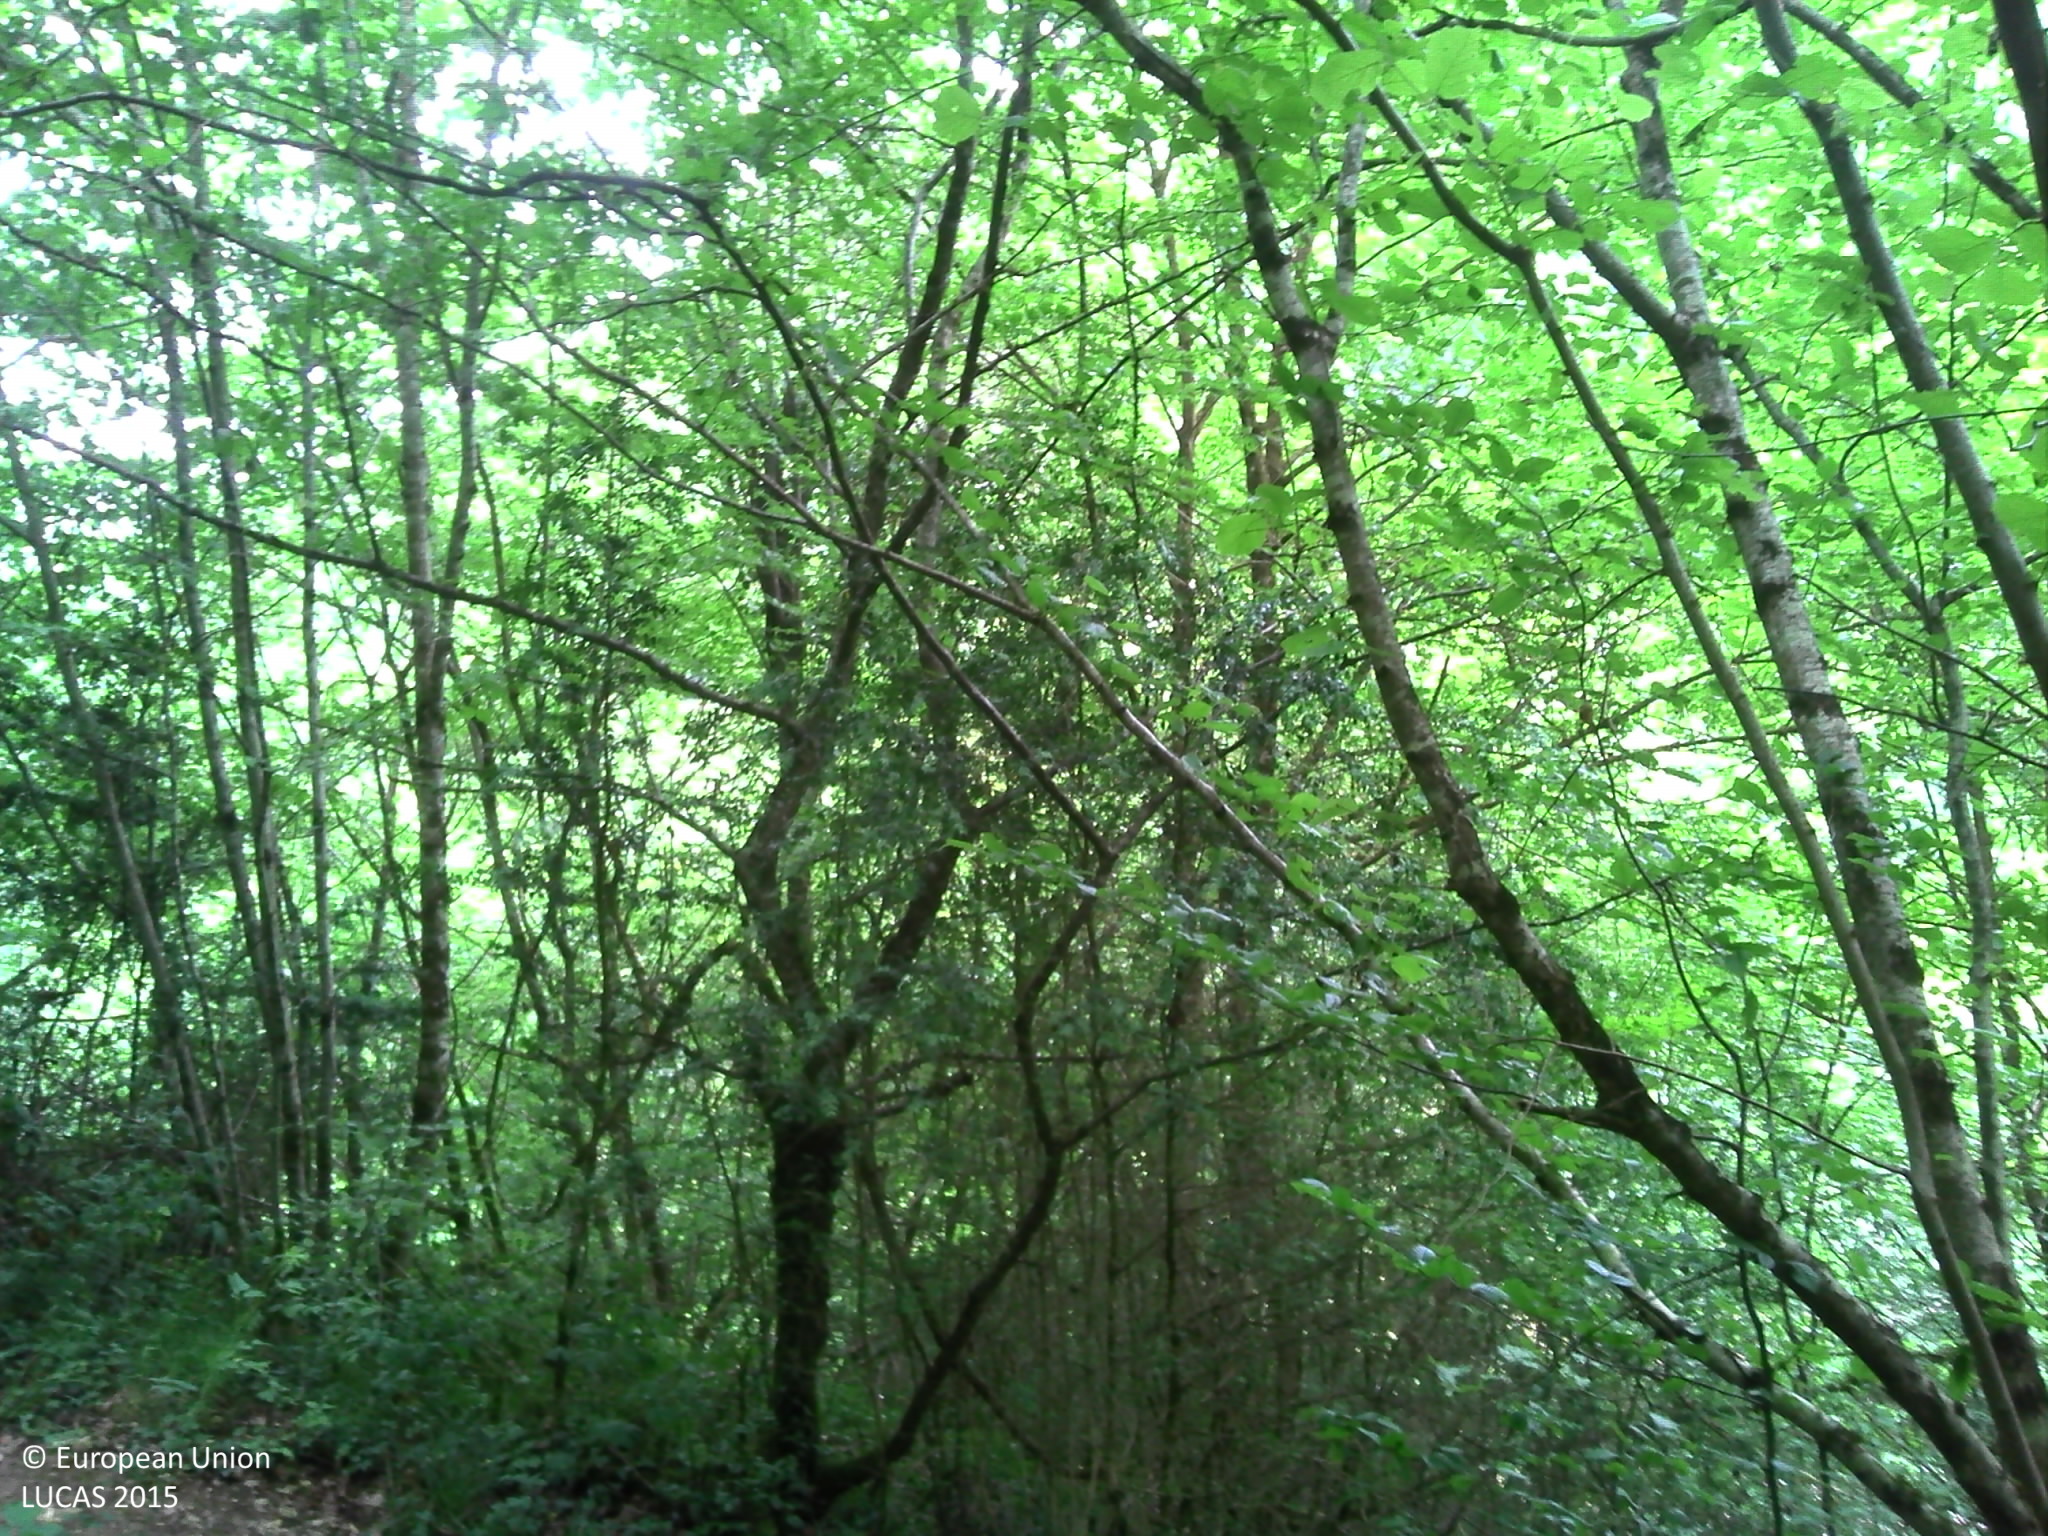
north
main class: Woodland
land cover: Broadleaved woodland
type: mesophytic deciduous forest
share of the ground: > 75 %
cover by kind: broadleaved forest trees 65 %, herbaceous plants 30 %, lichens and mosses 5 %
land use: Forestry
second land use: Amenities, museums, leisure
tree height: > 5 m
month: June
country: FR
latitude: 46.5495
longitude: 4.7979
